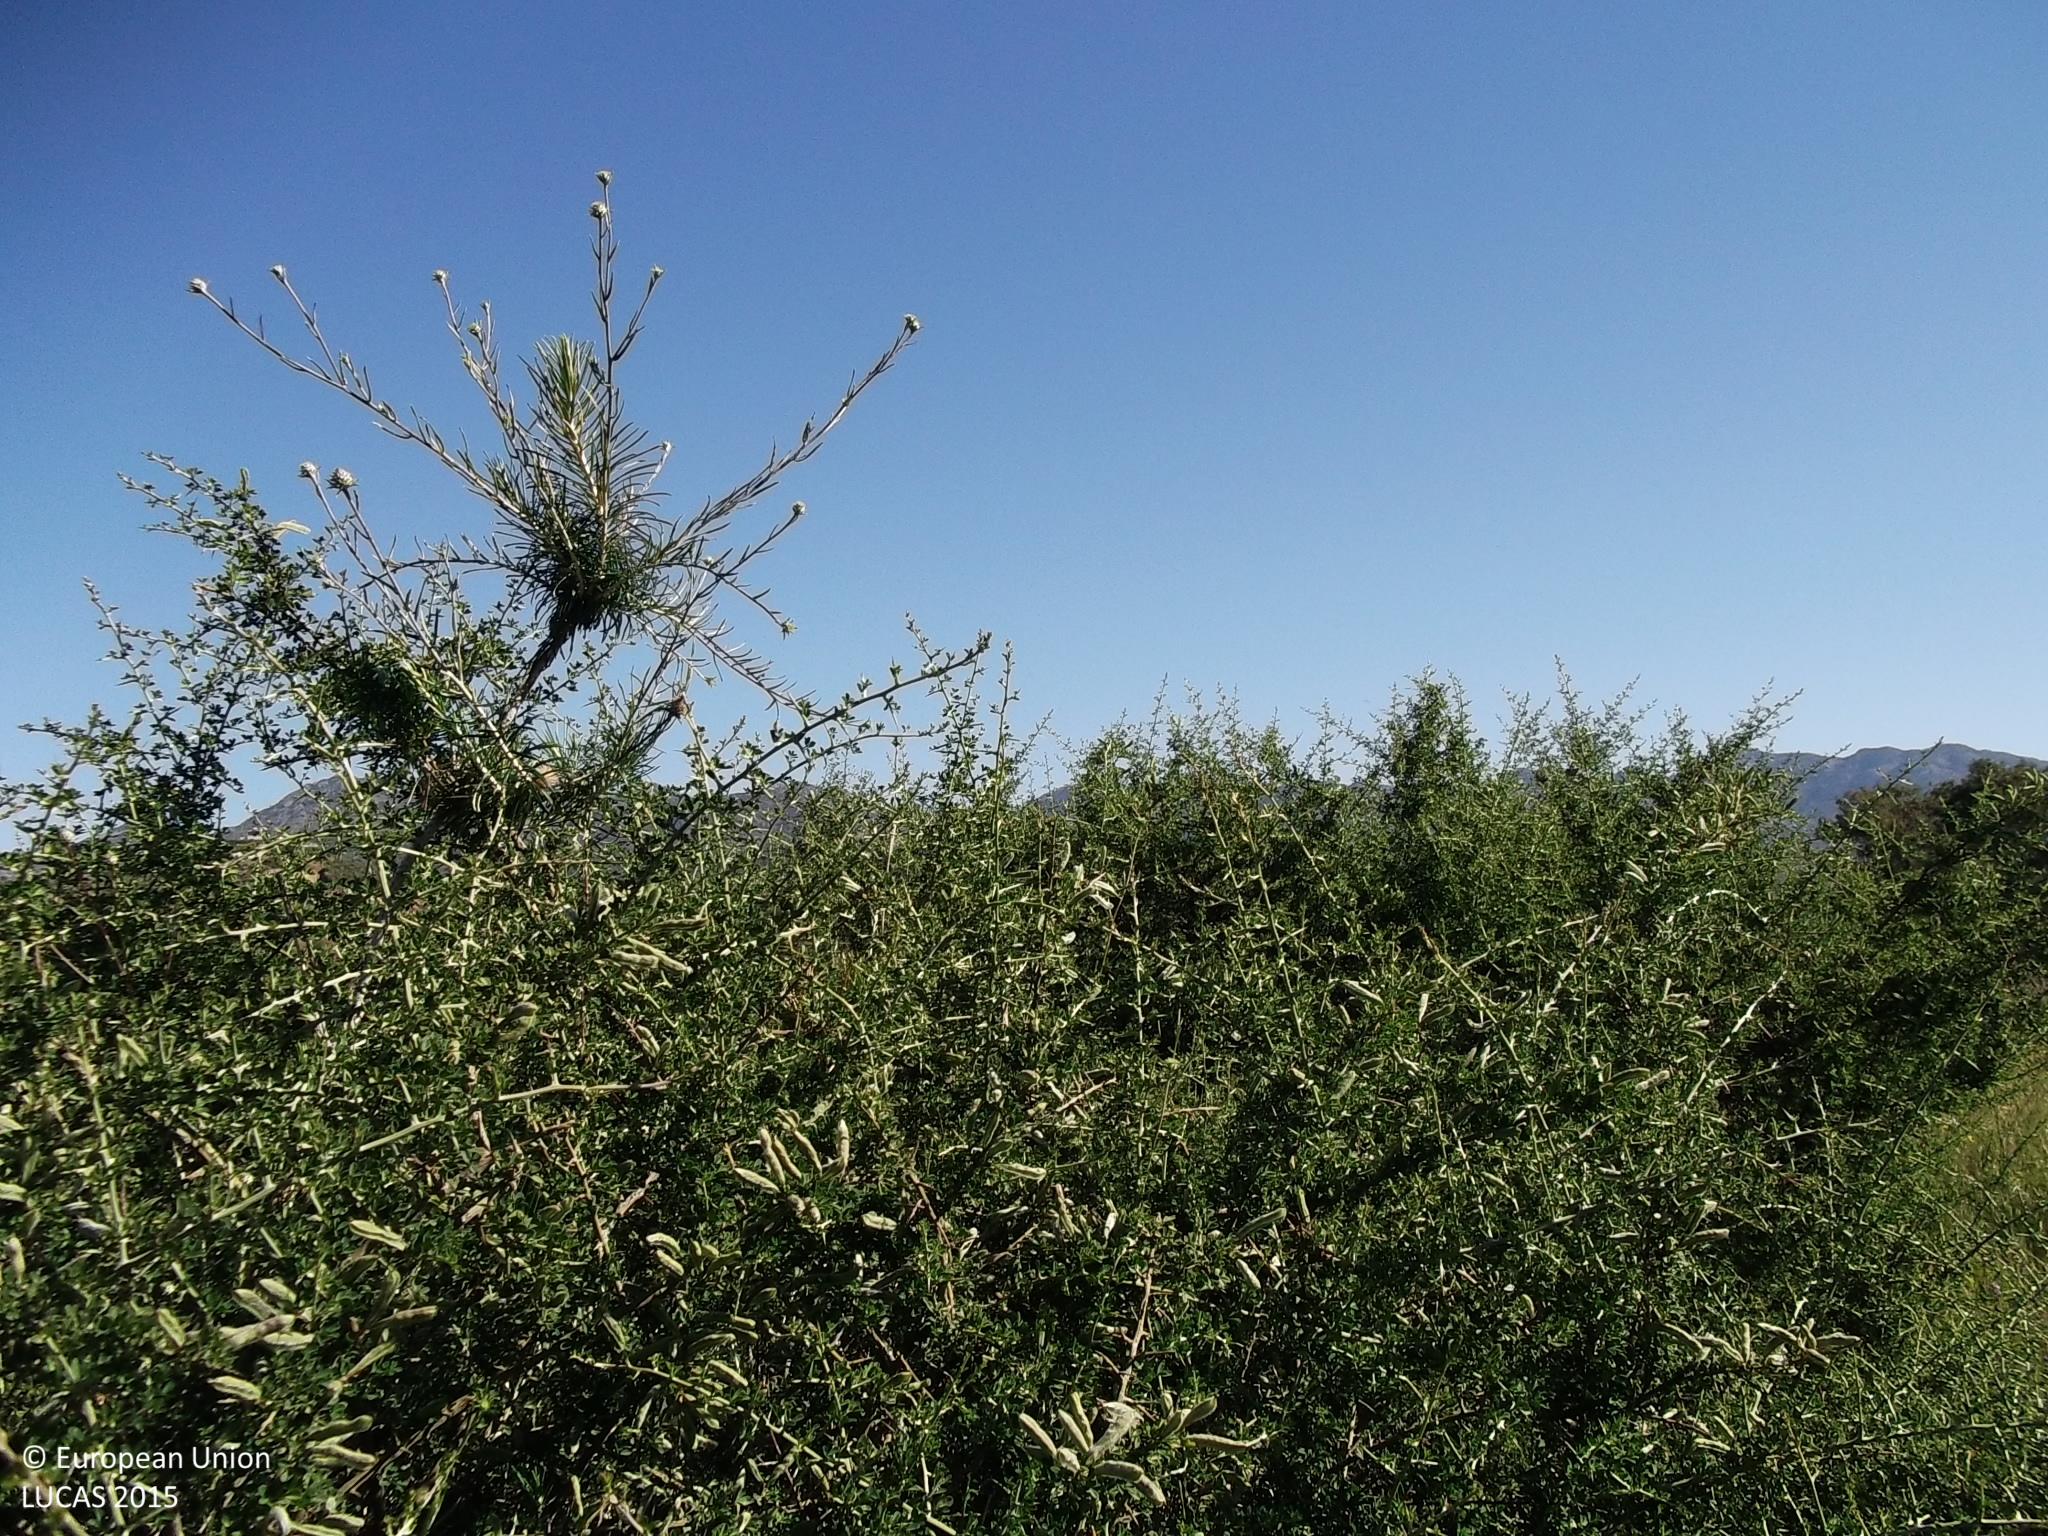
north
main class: Cropland
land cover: Oranges
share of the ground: 50 - 75 %
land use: Agriculture (excluding fallow land and kitchen gardens)
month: April
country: CY
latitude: 34.8313
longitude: 33.1470
